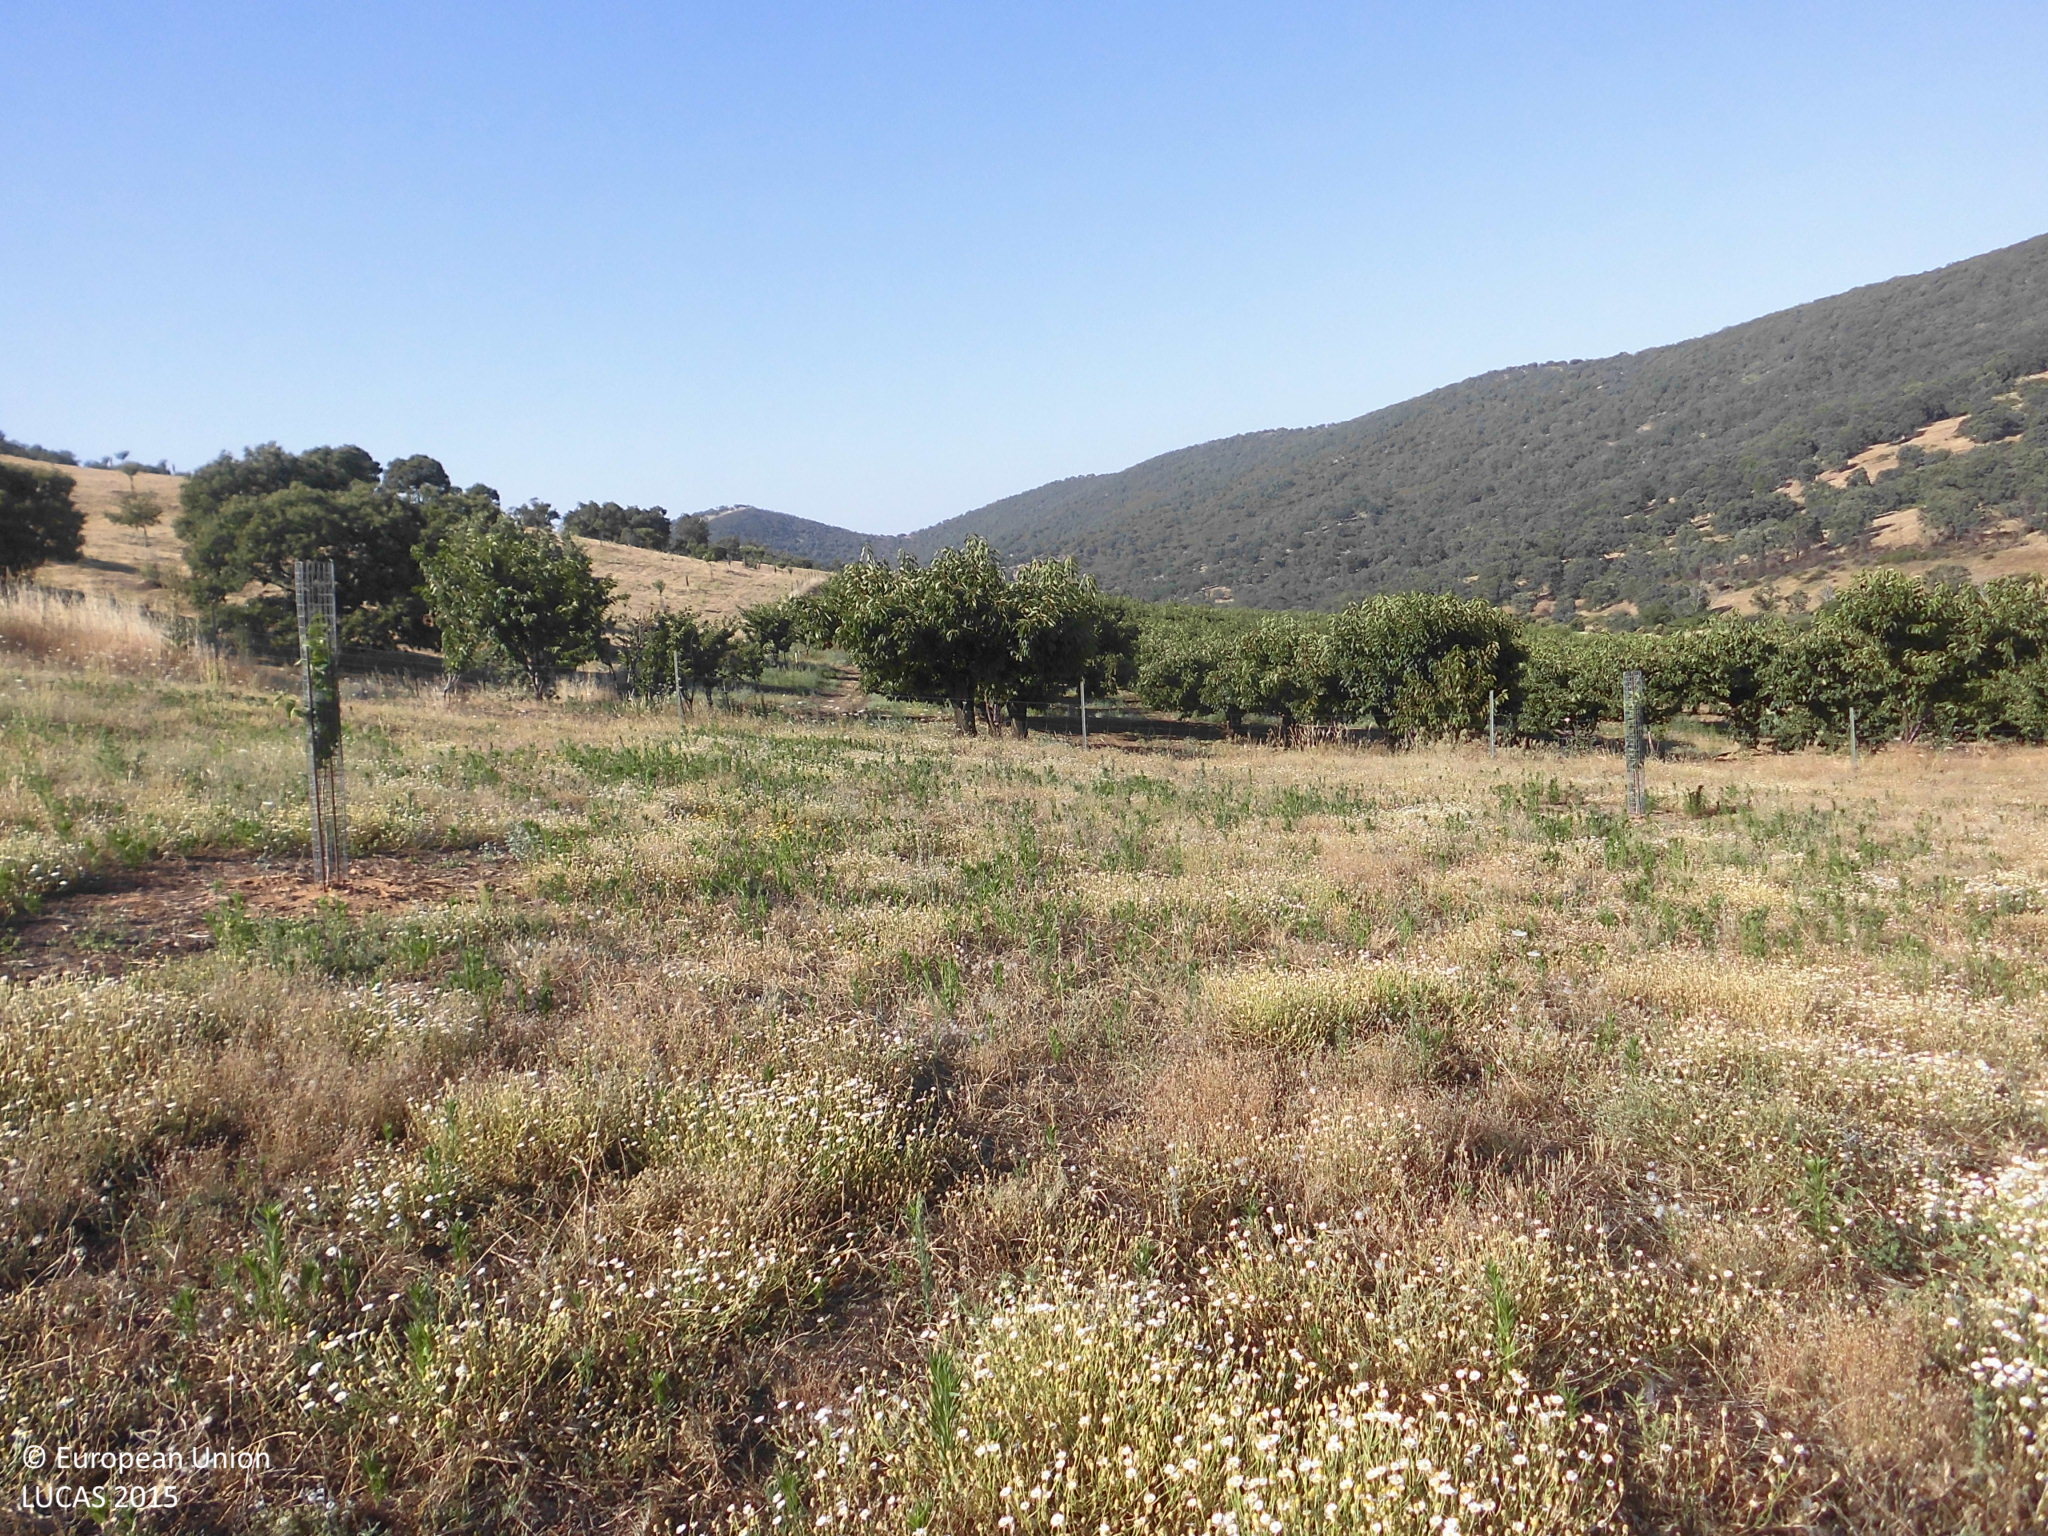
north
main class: Cropland
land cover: Nuts trees
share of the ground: < 10 %
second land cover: Grassland without tree/shrub cover
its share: > 75 %
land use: Agriculture (excluding fallow land and kitchen gardens)
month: July
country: ES
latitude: 39.4044
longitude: -5.5548
